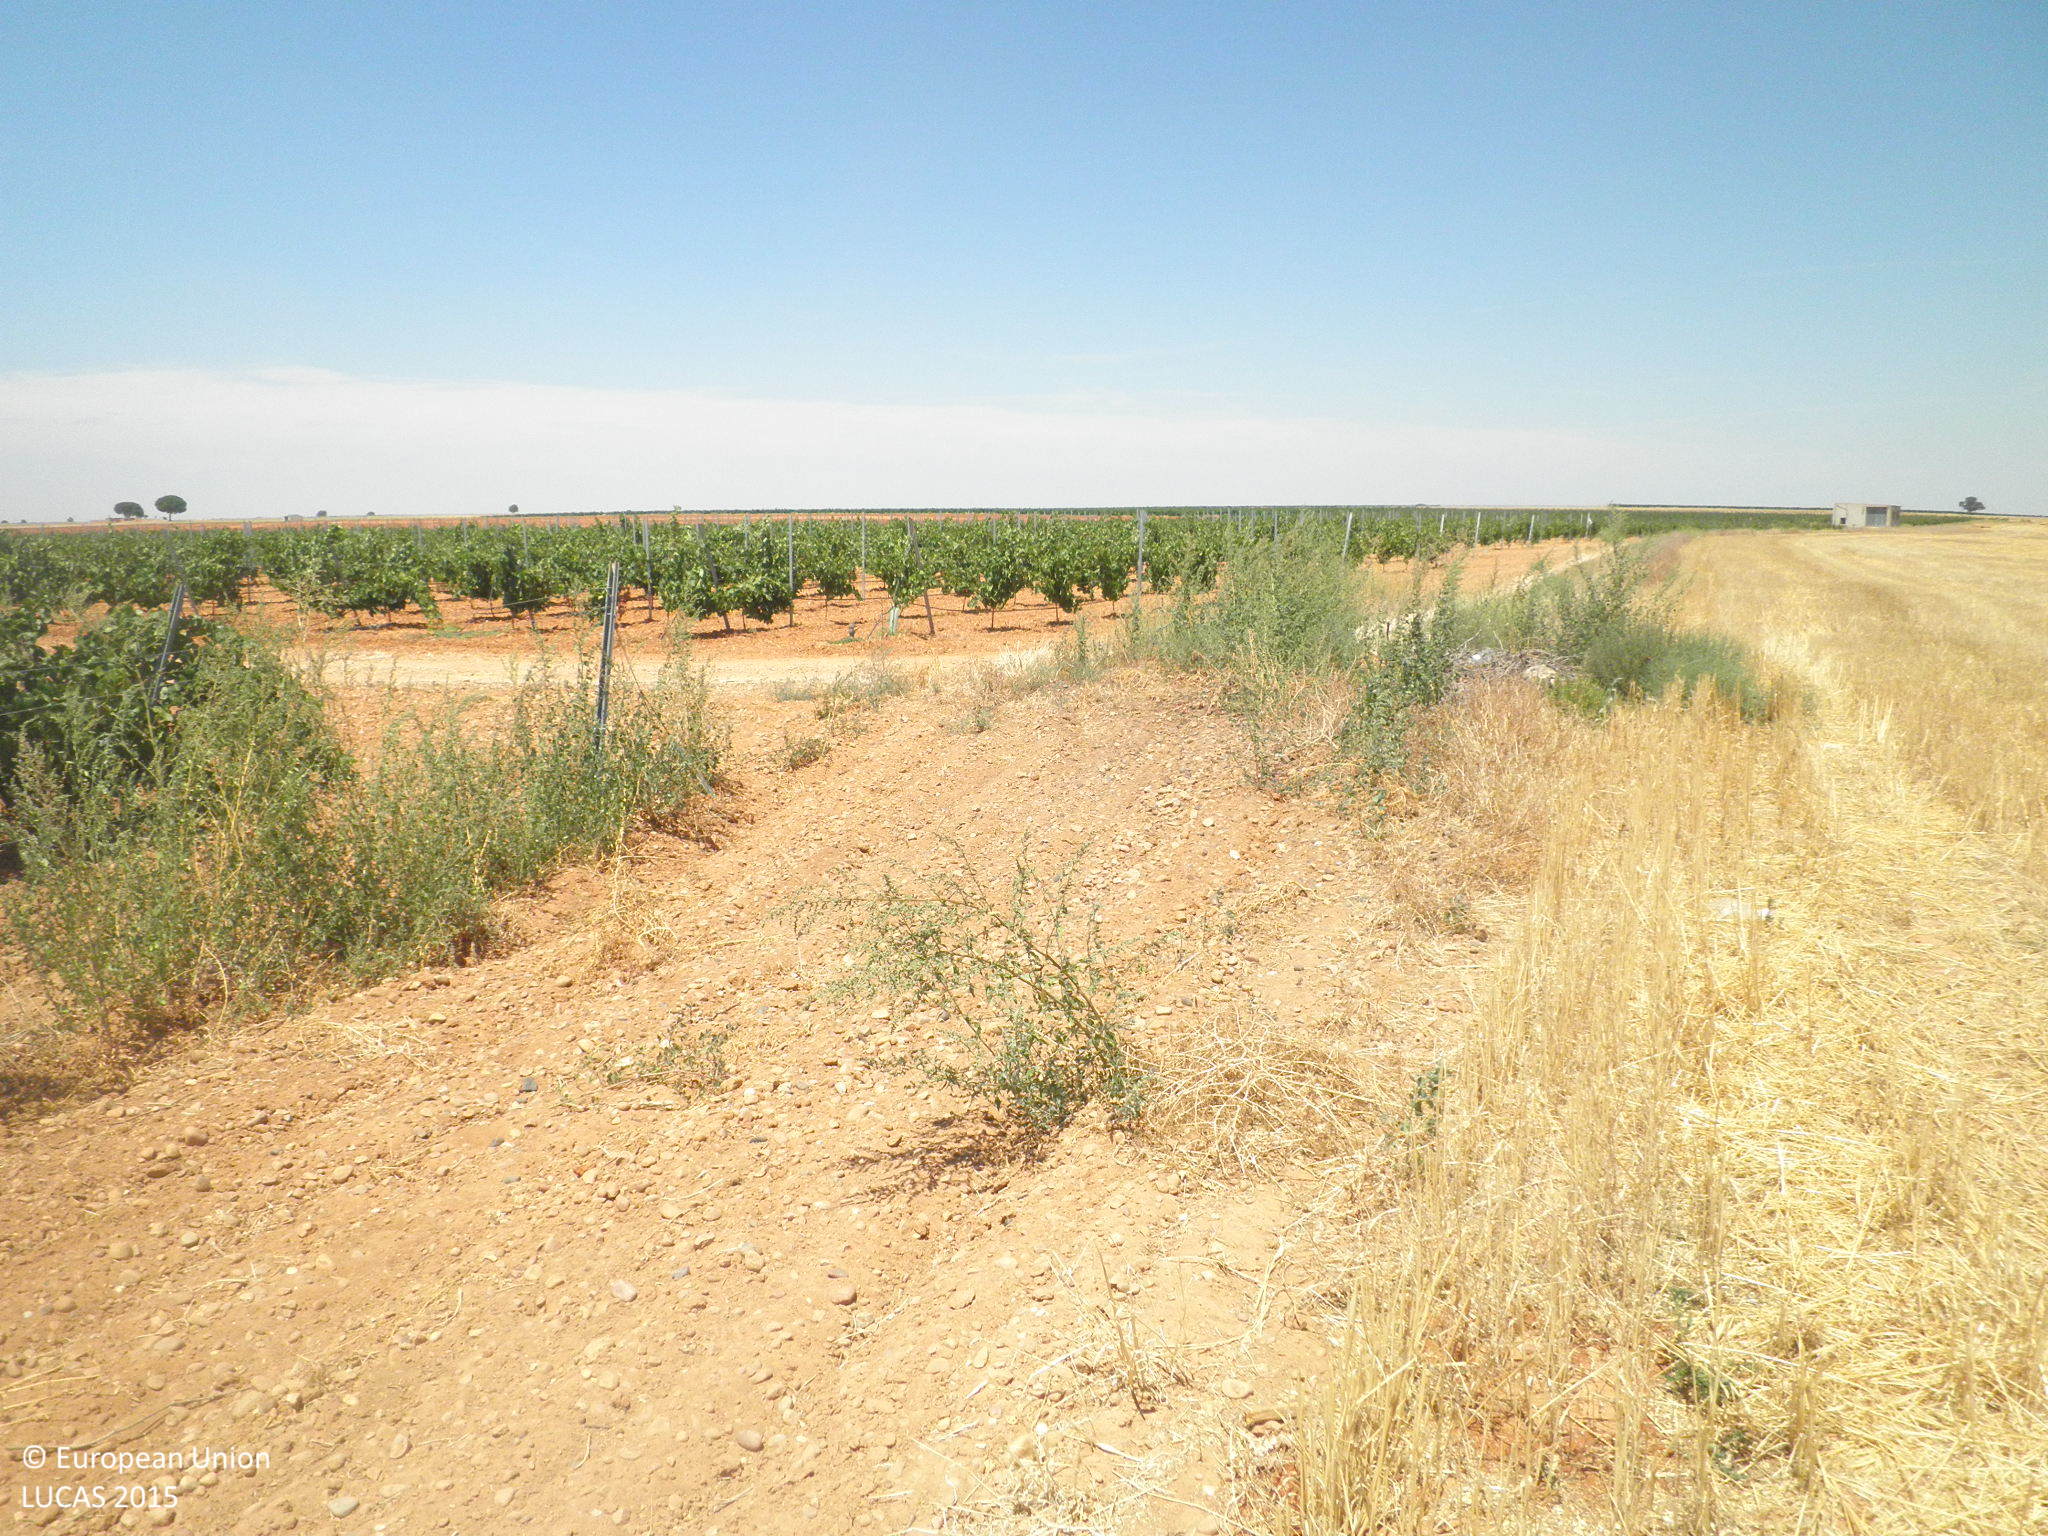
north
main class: Cropland
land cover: Durum wheat
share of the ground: < 10 %
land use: Agriculture (excluding fallow land and kitchen gardens)
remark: Harvested field
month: July
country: ES
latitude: 39.3537
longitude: -1.7830
